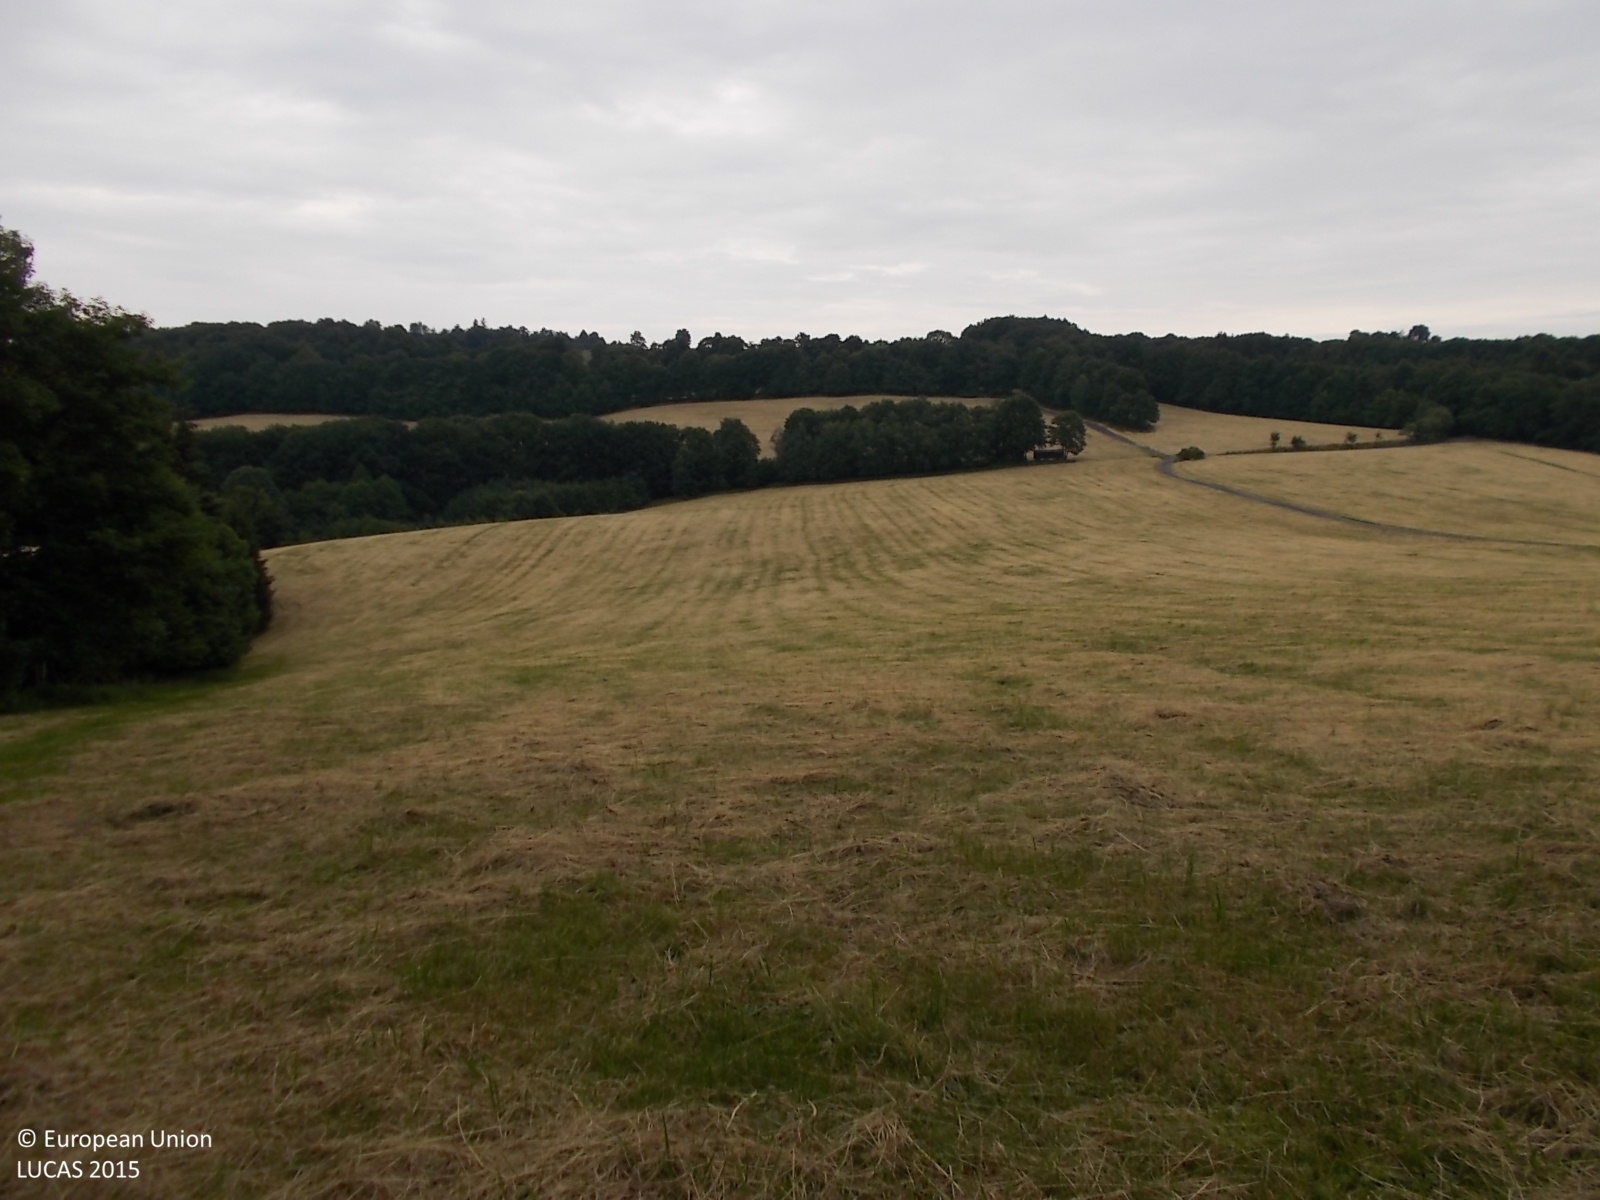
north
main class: Grassland
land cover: Grassland without tree/shrub cover
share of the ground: > 75 %
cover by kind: herbaceous plants 100 %
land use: Agriculture (excluding fallow land and kitchen gardens)
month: June
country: CZ
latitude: 49.5849
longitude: 17.6343
